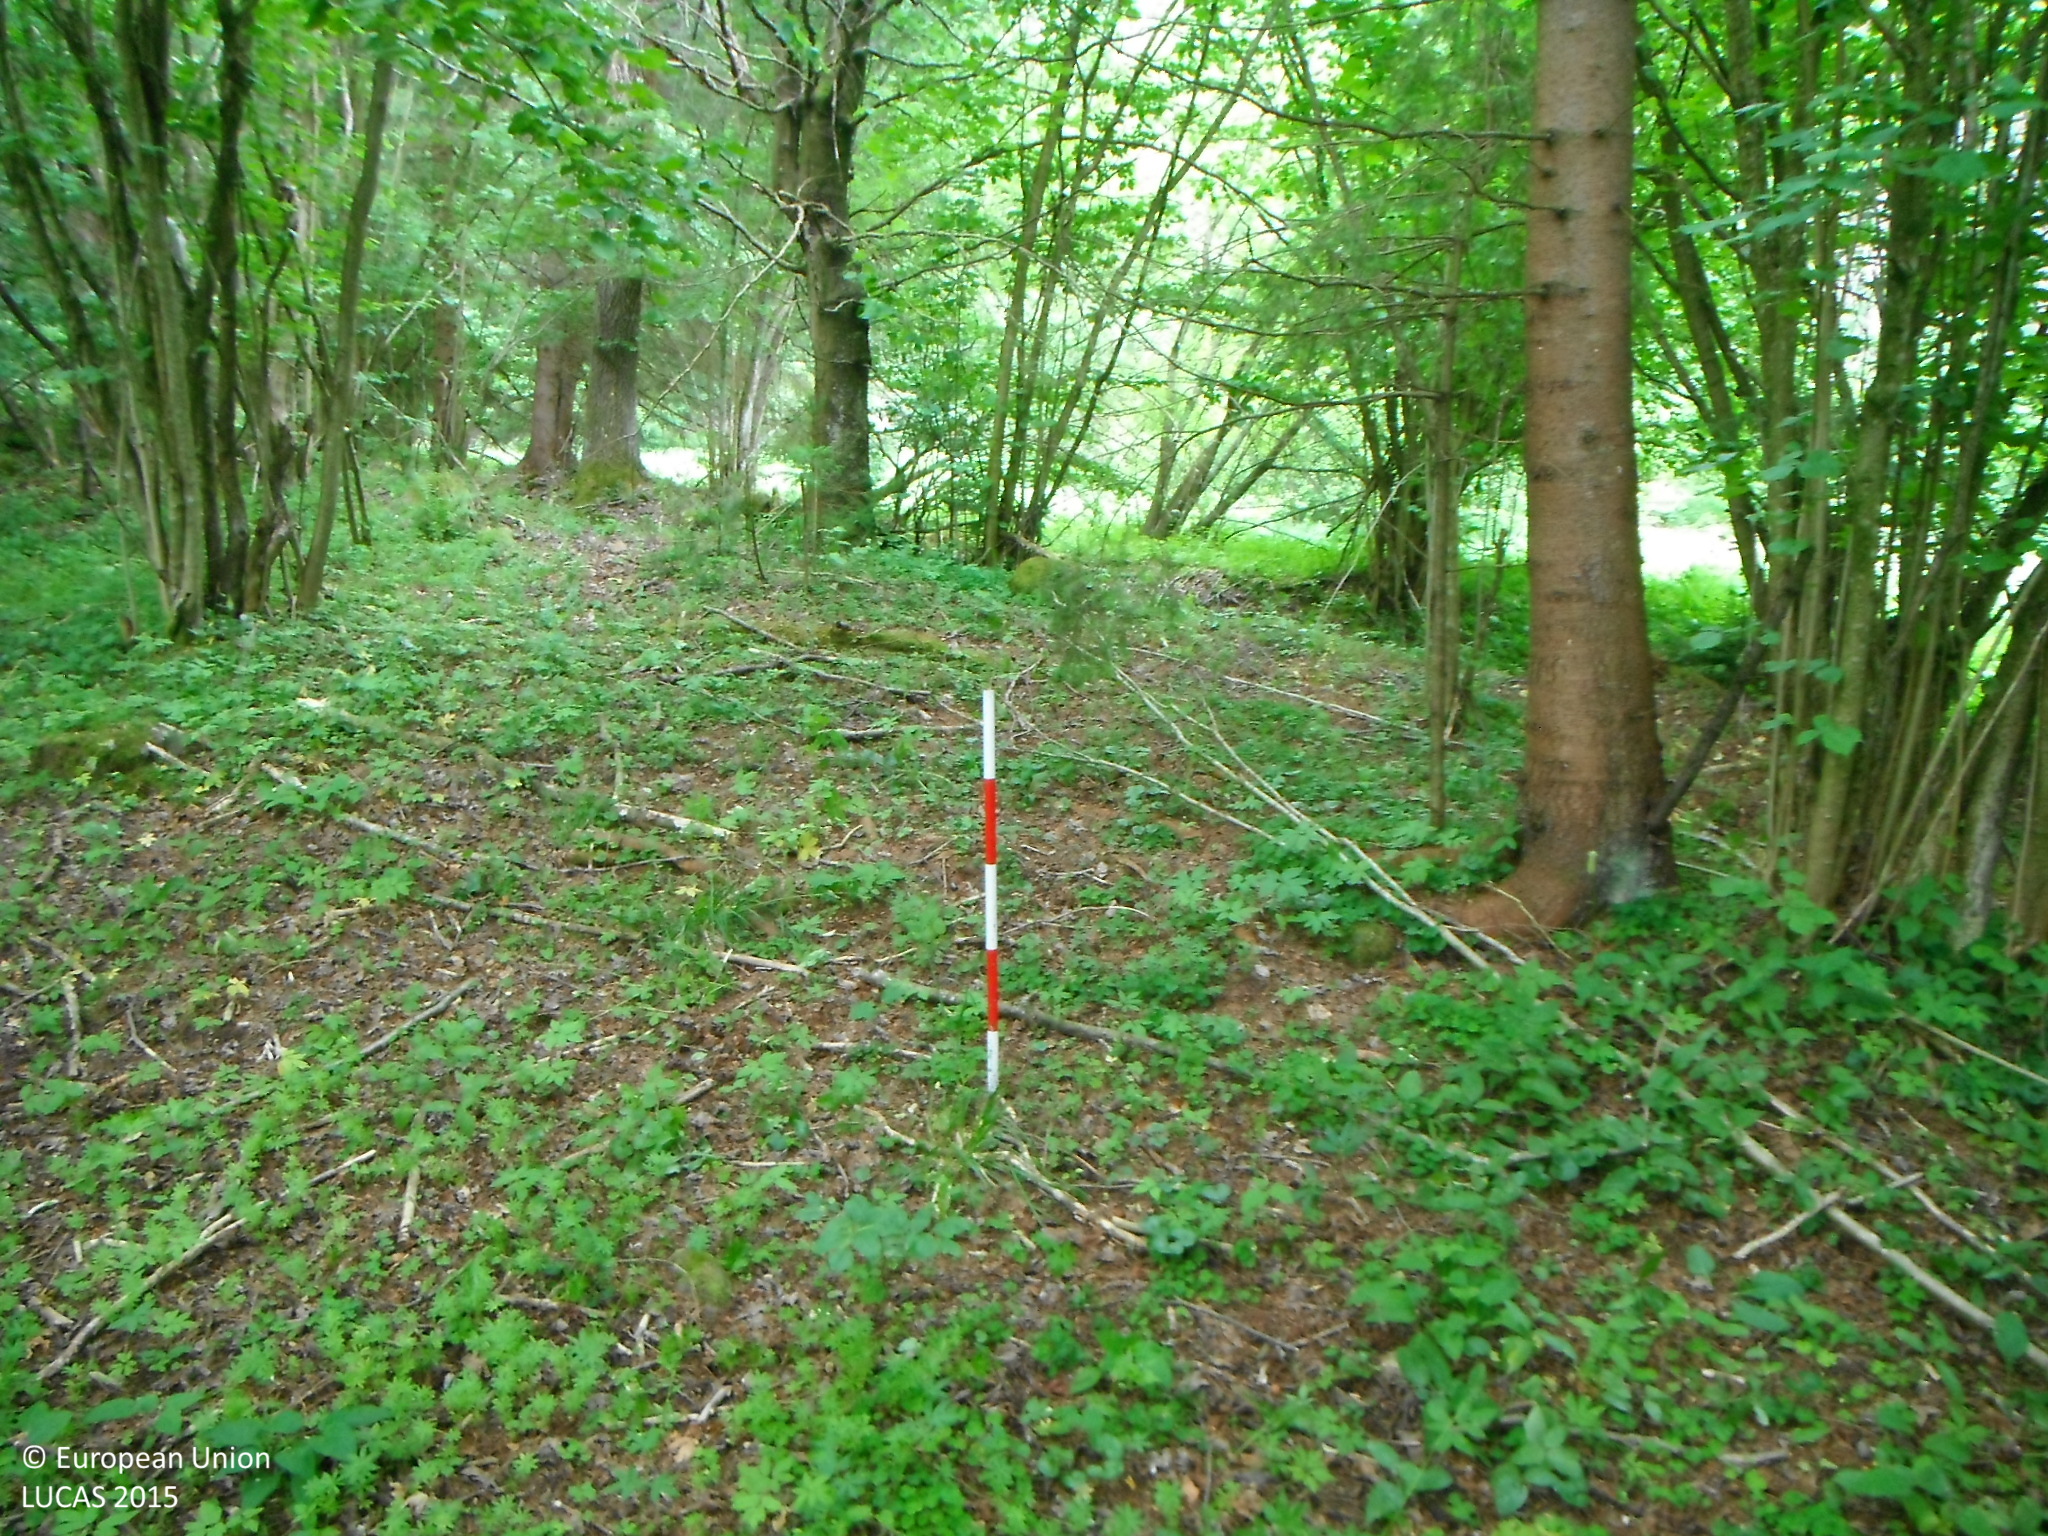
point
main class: Woodland
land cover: Spruce dominated mixed woodland
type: hemiboreal forest and nemoral coniferous forest and mixed broadleaved-coniferous forest
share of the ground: > 75 %
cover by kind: broadleaved forest trees 70 %, coniferous forest trees 30 %
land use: Forestry
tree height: > 5 m
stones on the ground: < 10 %
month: June
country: SK
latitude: 48.6516
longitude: 19.4316
